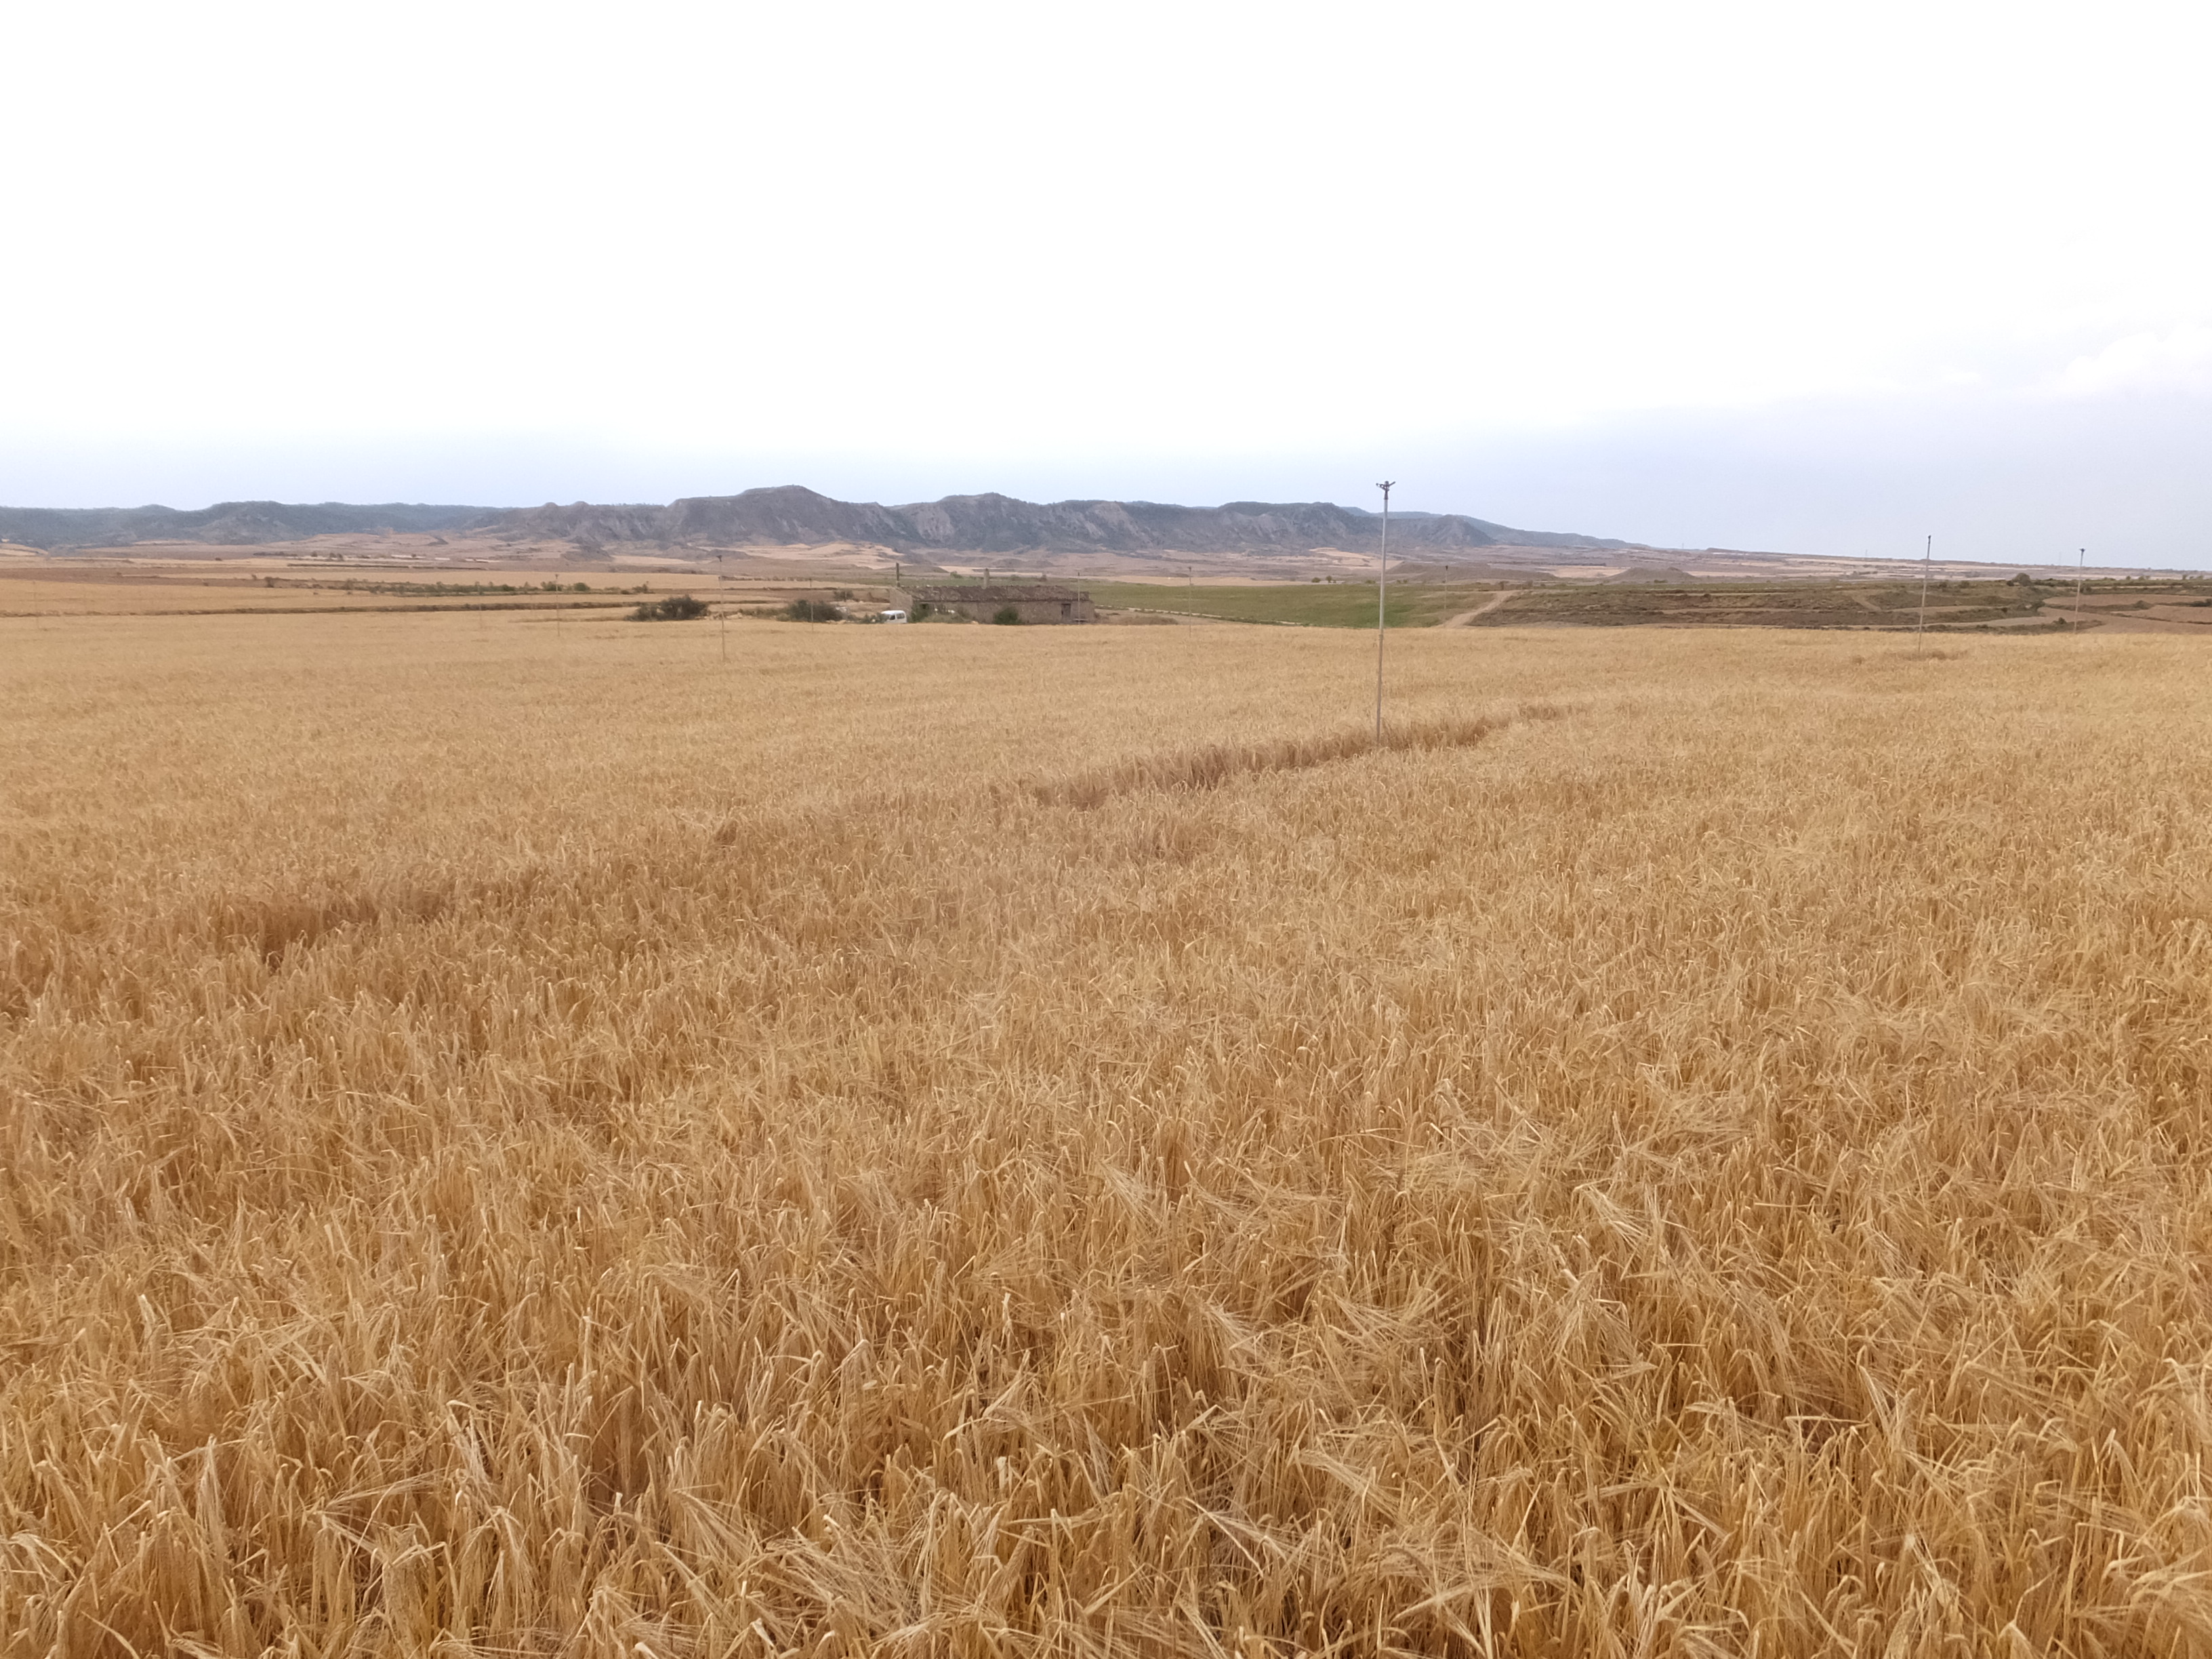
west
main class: Cropland
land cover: Barley
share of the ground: > 75 %
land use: Agriculture (excluding fallow land and kitchen gardens)
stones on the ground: < 10 %
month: June
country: ES
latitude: 41.6541
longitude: 0.0538
